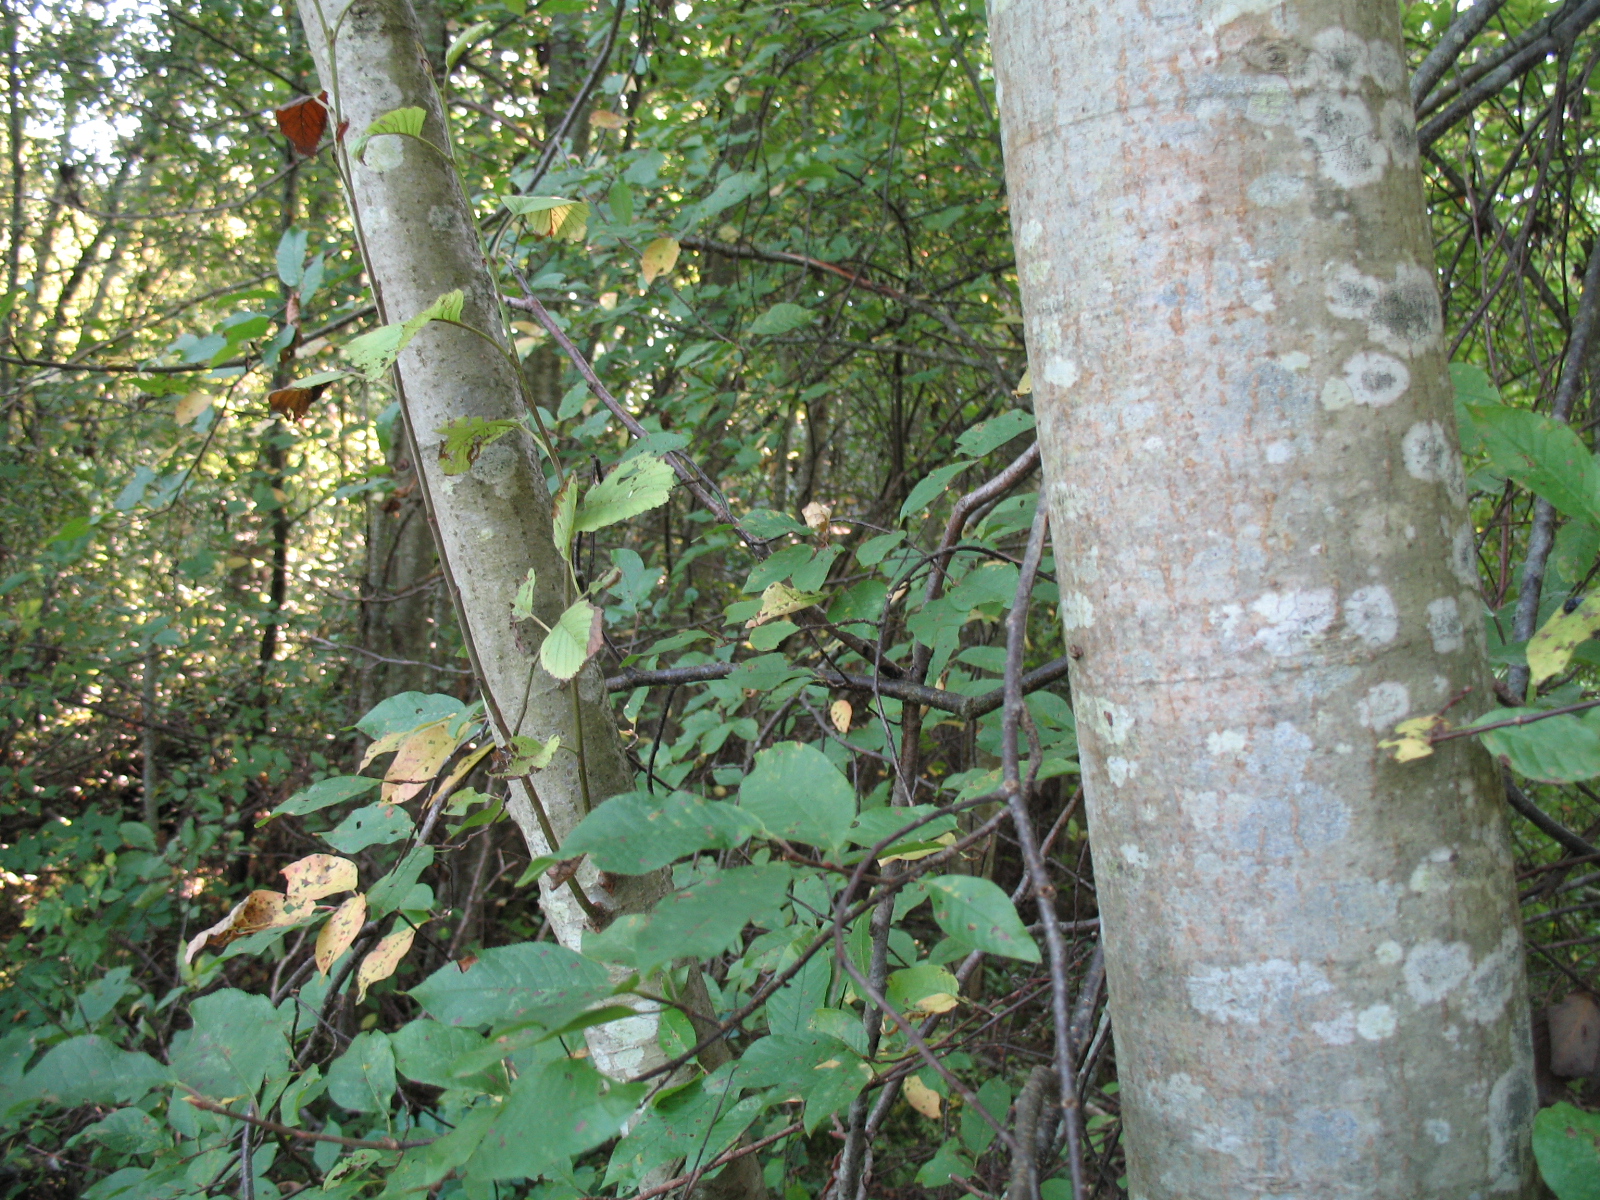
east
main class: Woodland
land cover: Broadleaved woodland
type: non-riverine alder, birch or aspen forest
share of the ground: > 75 %
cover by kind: broadleaved forest trees 90 %, shrubs 5 %, herbaceous plants 5 %
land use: Forestry
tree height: > 5 m
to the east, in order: Broadleaved woodland; Spontaneously vegetated surfaces; Broadleaved woodland; Grassland without tree/shrub cover; Electric lines
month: August
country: LV
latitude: 56.2506
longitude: 25.4691
